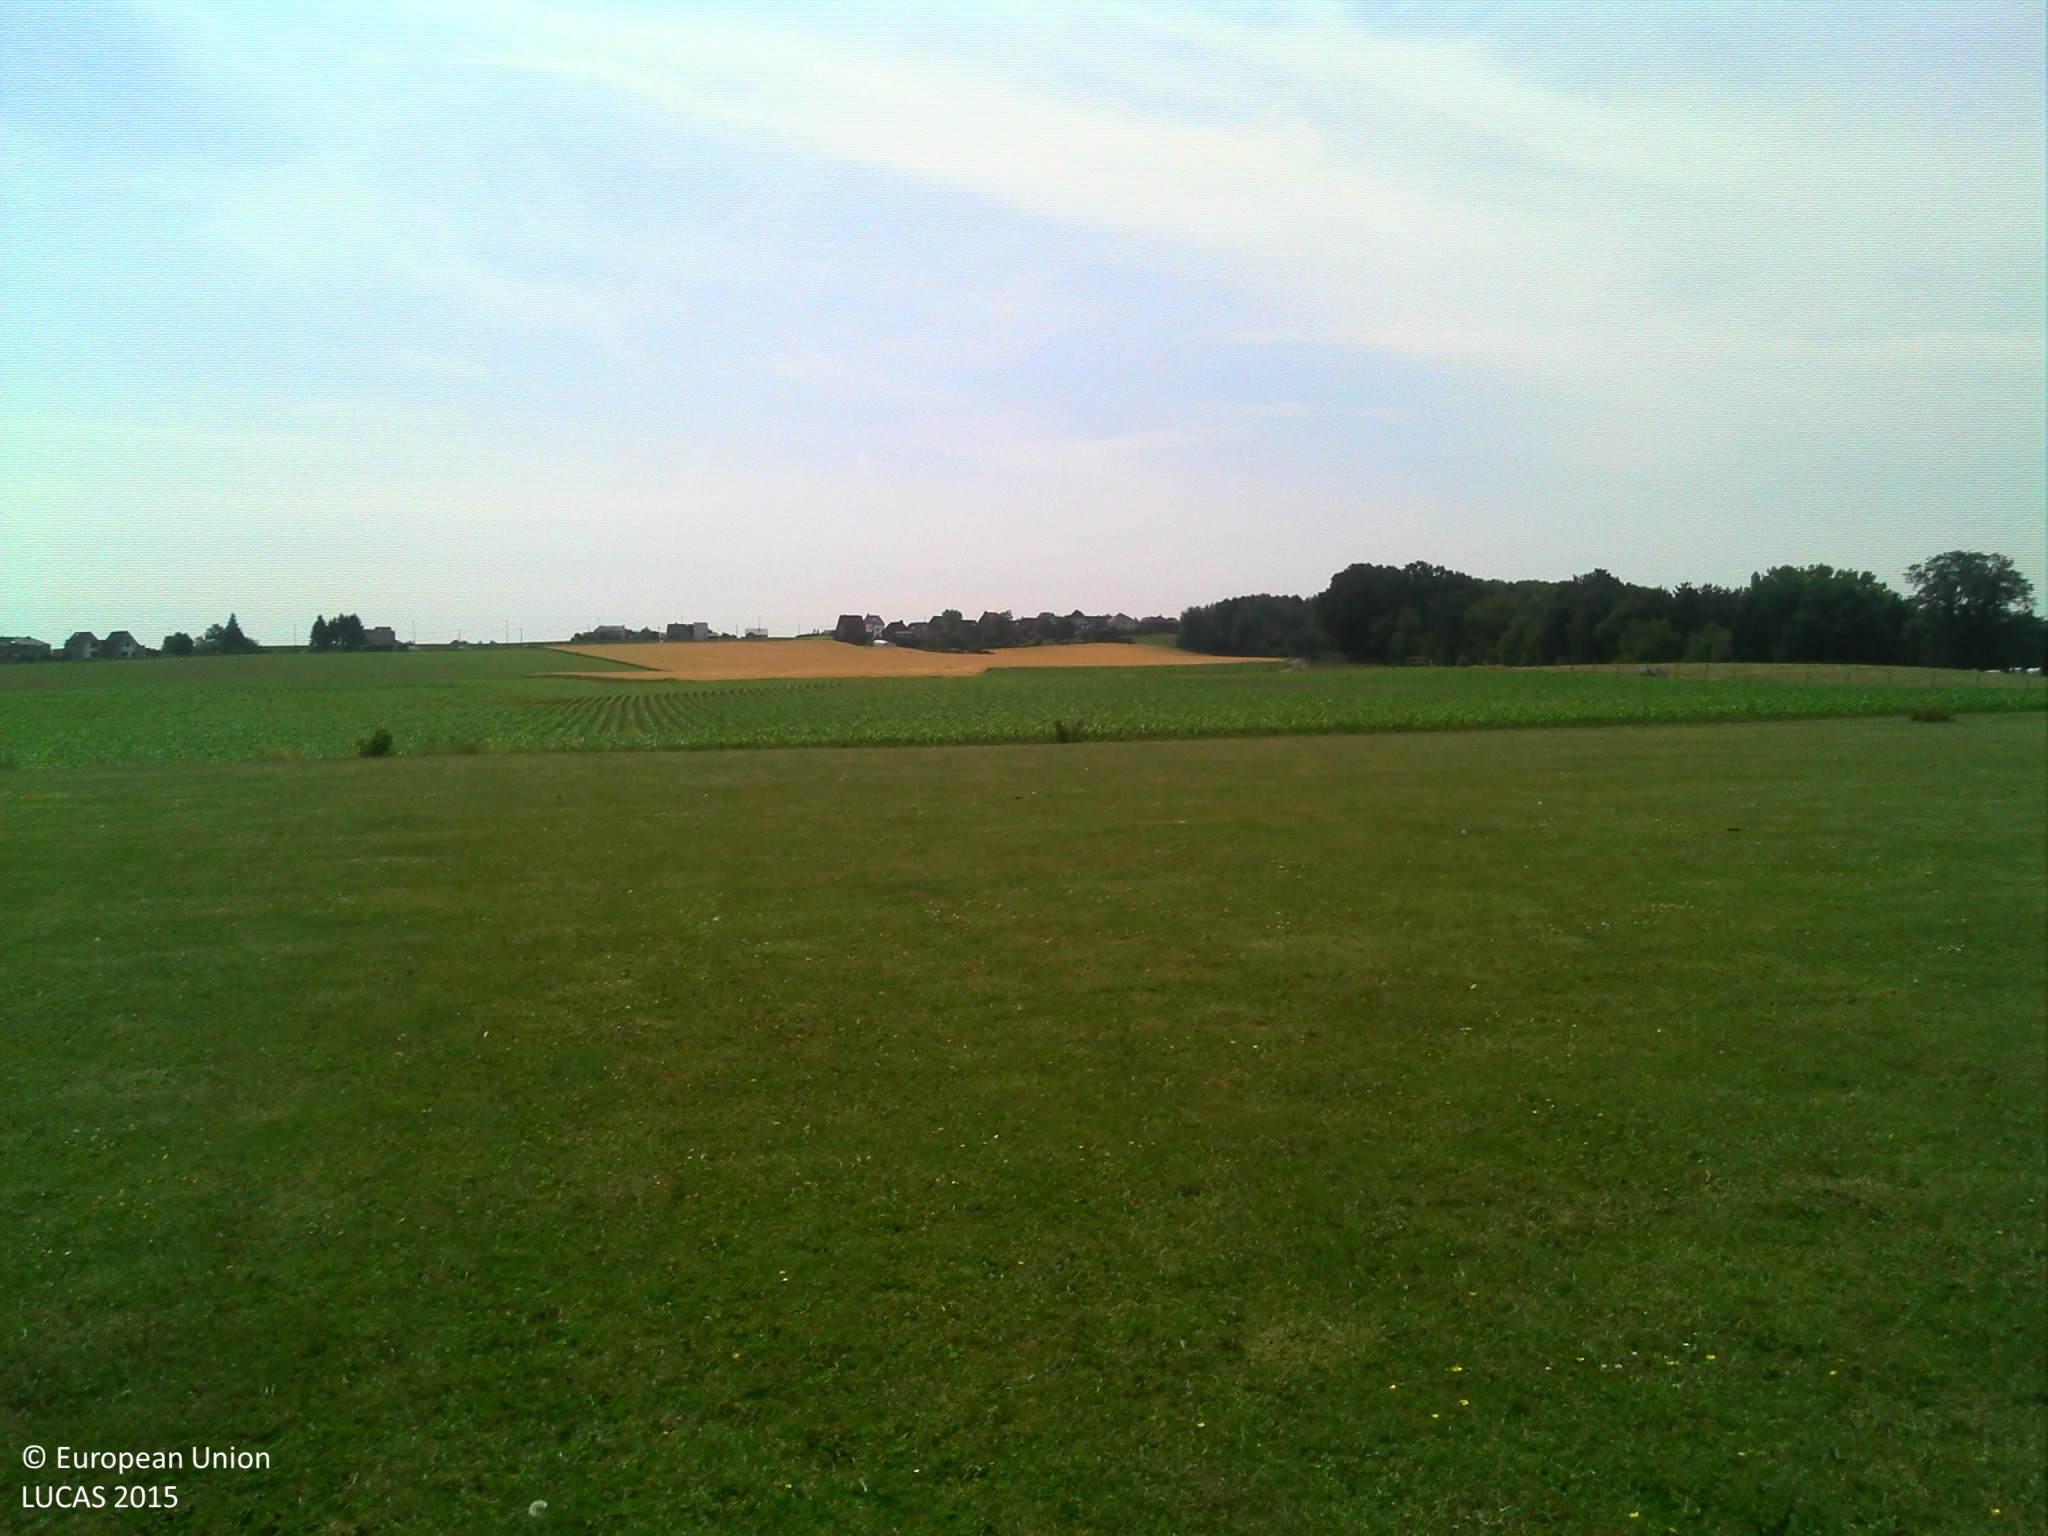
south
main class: Grassland
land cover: Grassland without tree/shrub cover
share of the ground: > 75 %
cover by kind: herbaceous plants 95 %, shrubs 5 %
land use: Sport
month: June
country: BE
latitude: 50.8293
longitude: 4.5583
